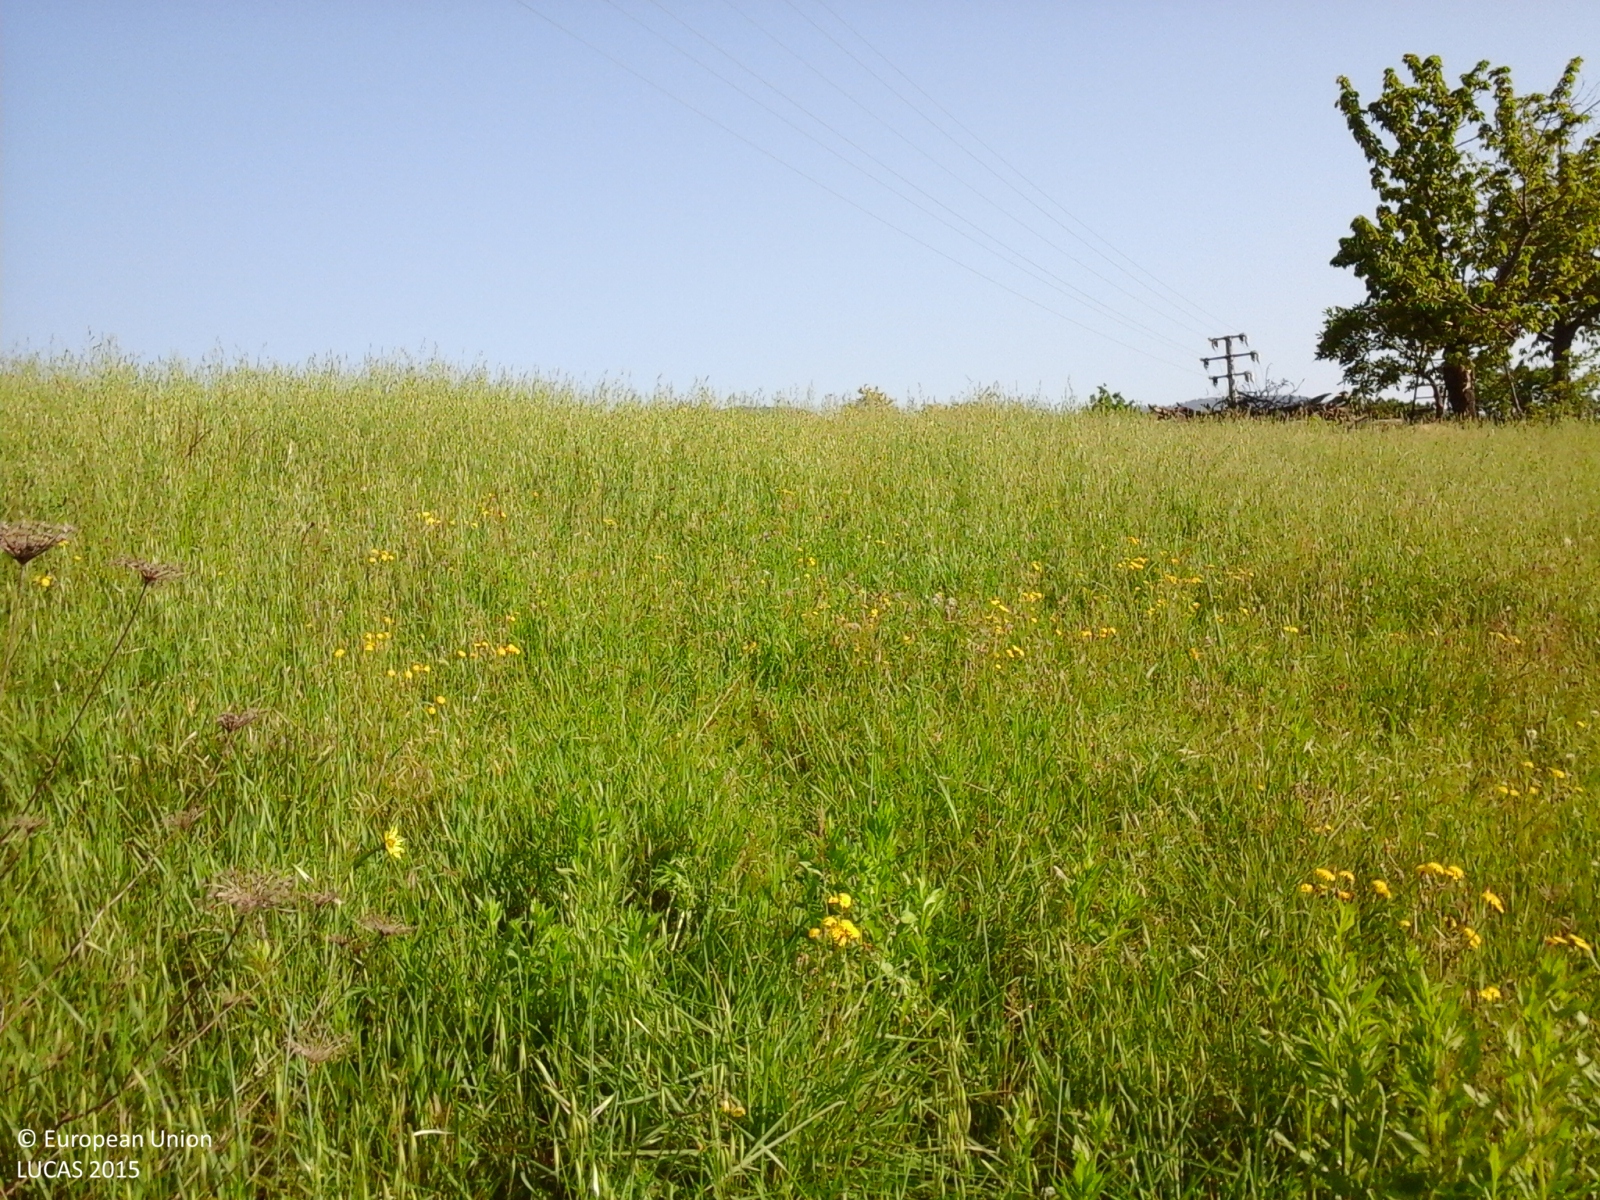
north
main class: Woodland
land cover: Broadleaved woodland
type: mesophytic deciduous forest
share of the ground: > 75 %
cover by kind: broadleaved forest trees 100 %
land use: Forestry
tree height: > 5 m
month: May
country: IT
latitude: 44.7635
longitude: 9.3822
